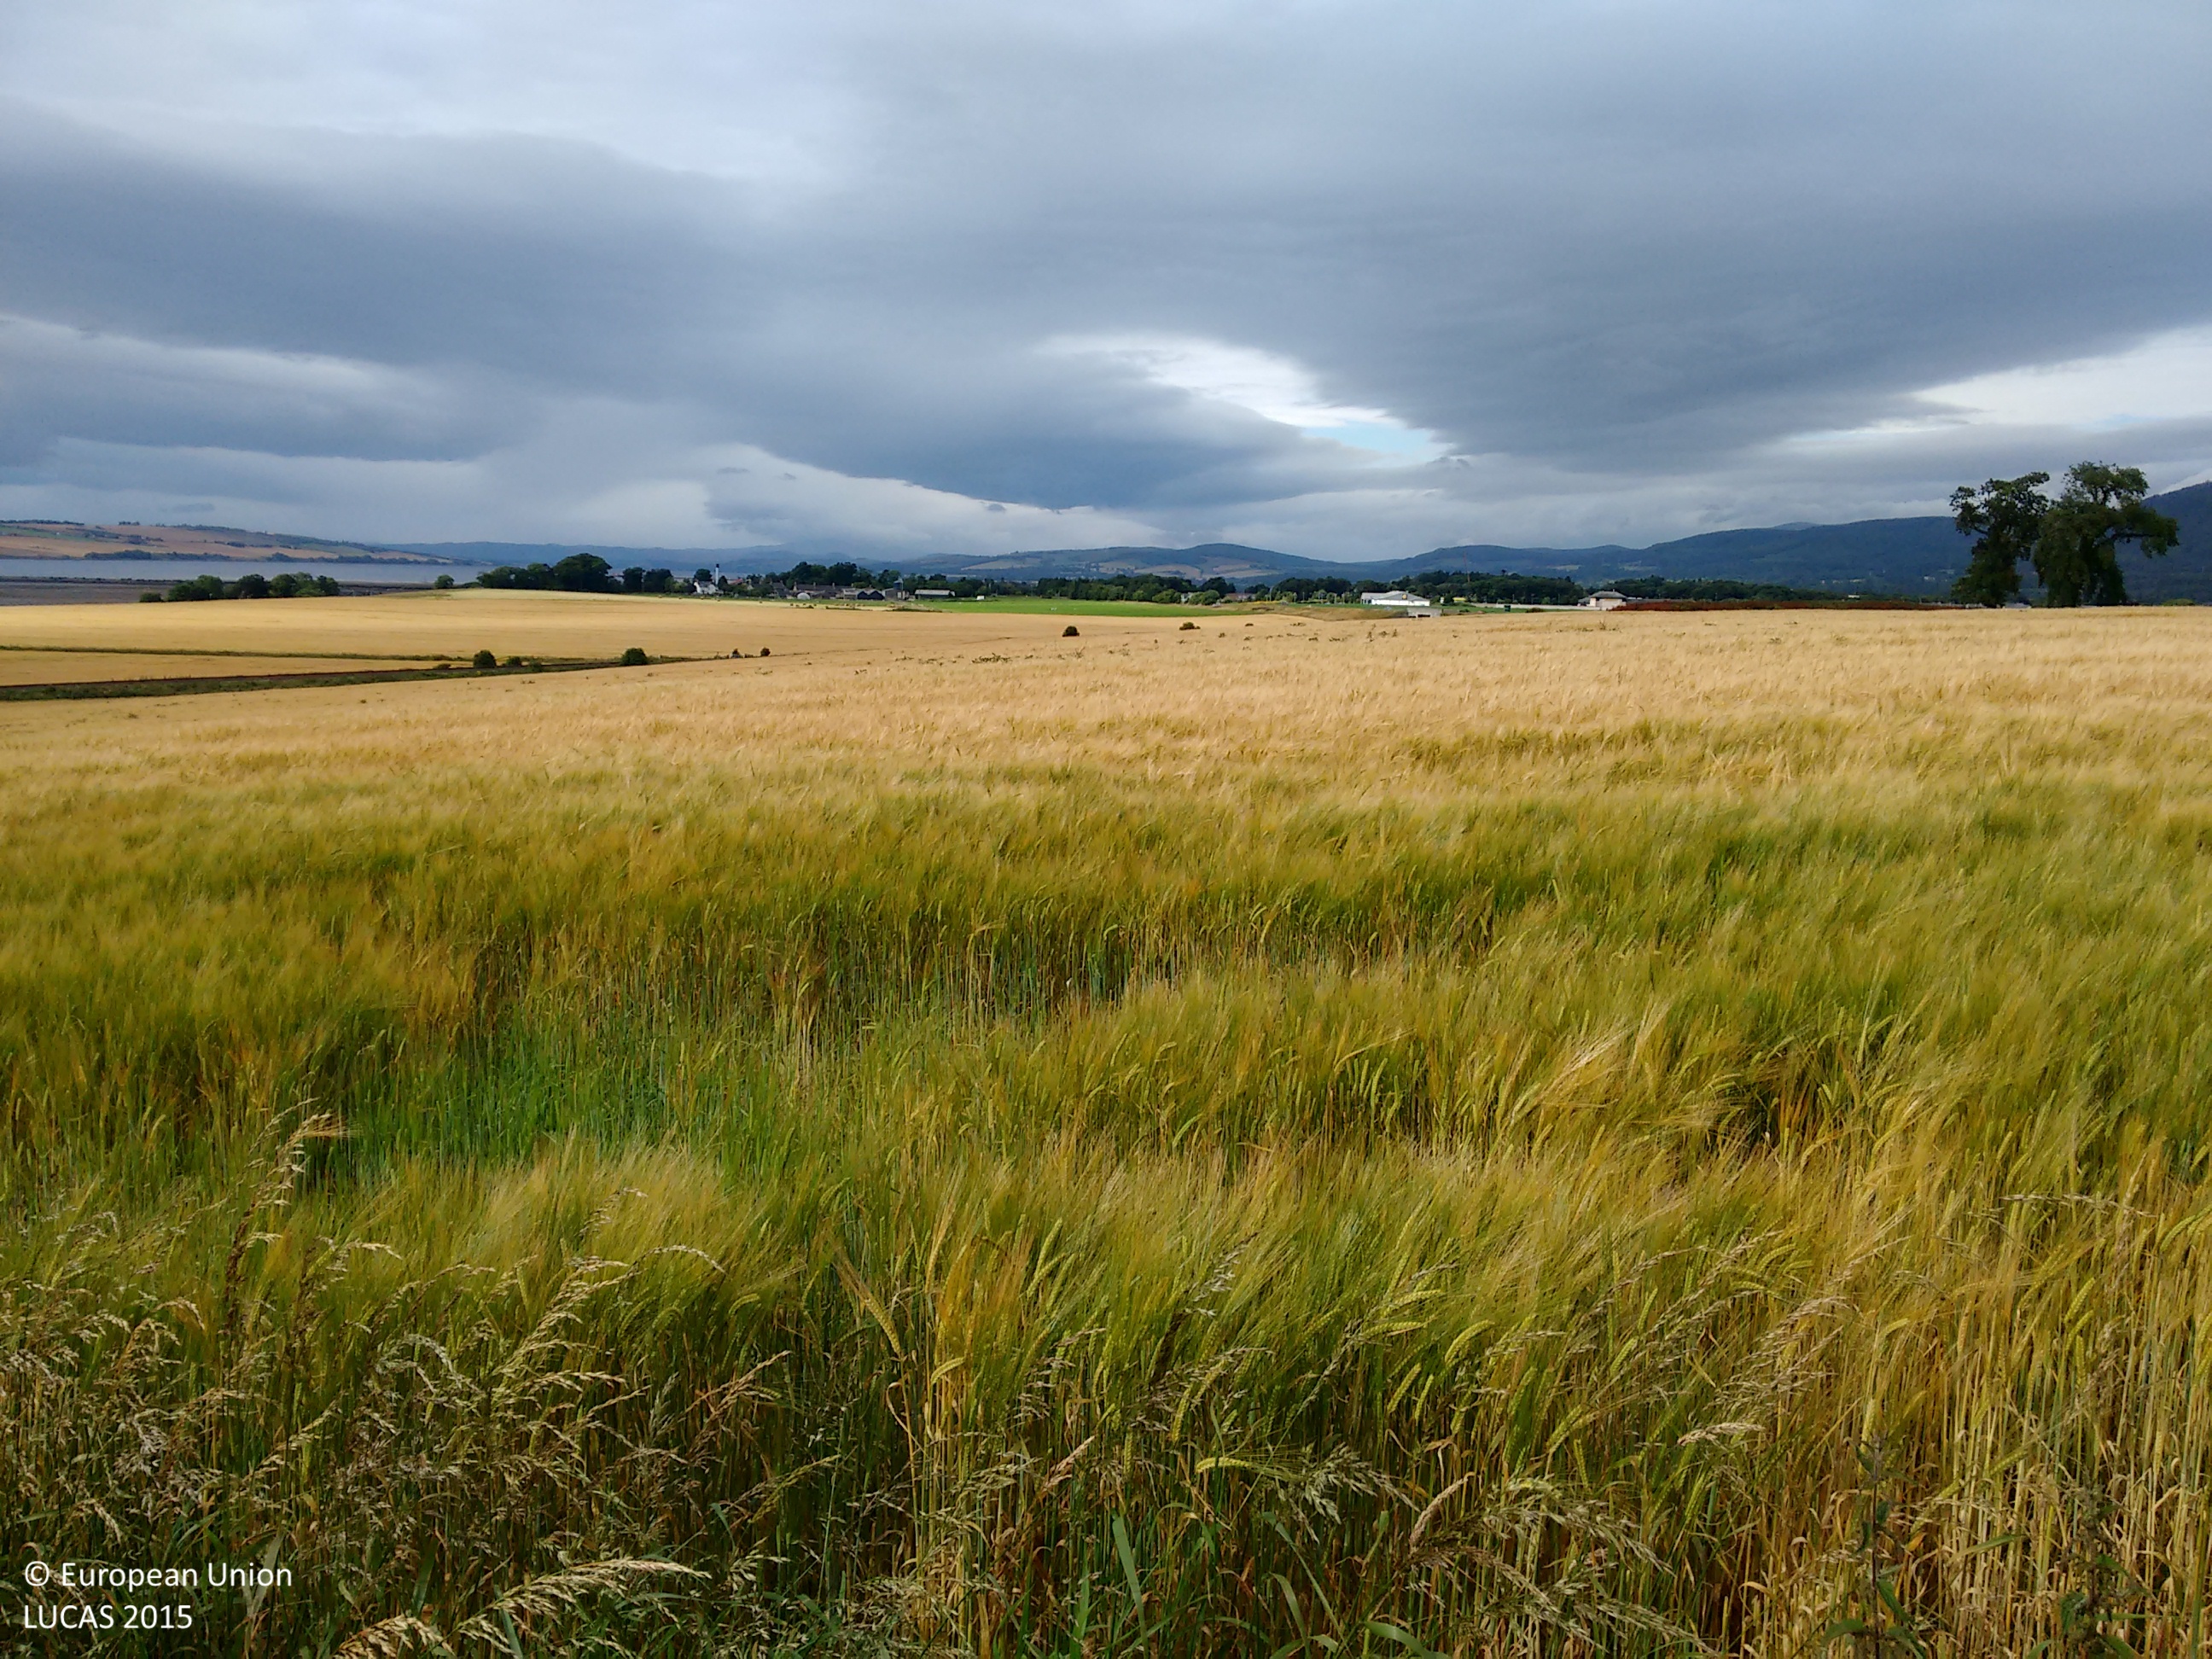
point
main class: Cropland
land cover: Barley
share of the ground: > 75 %
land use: Agriculture (excluding fallow land and kitchen gardens)
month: August
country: GB
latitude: 57.6952
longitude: -4.2269
